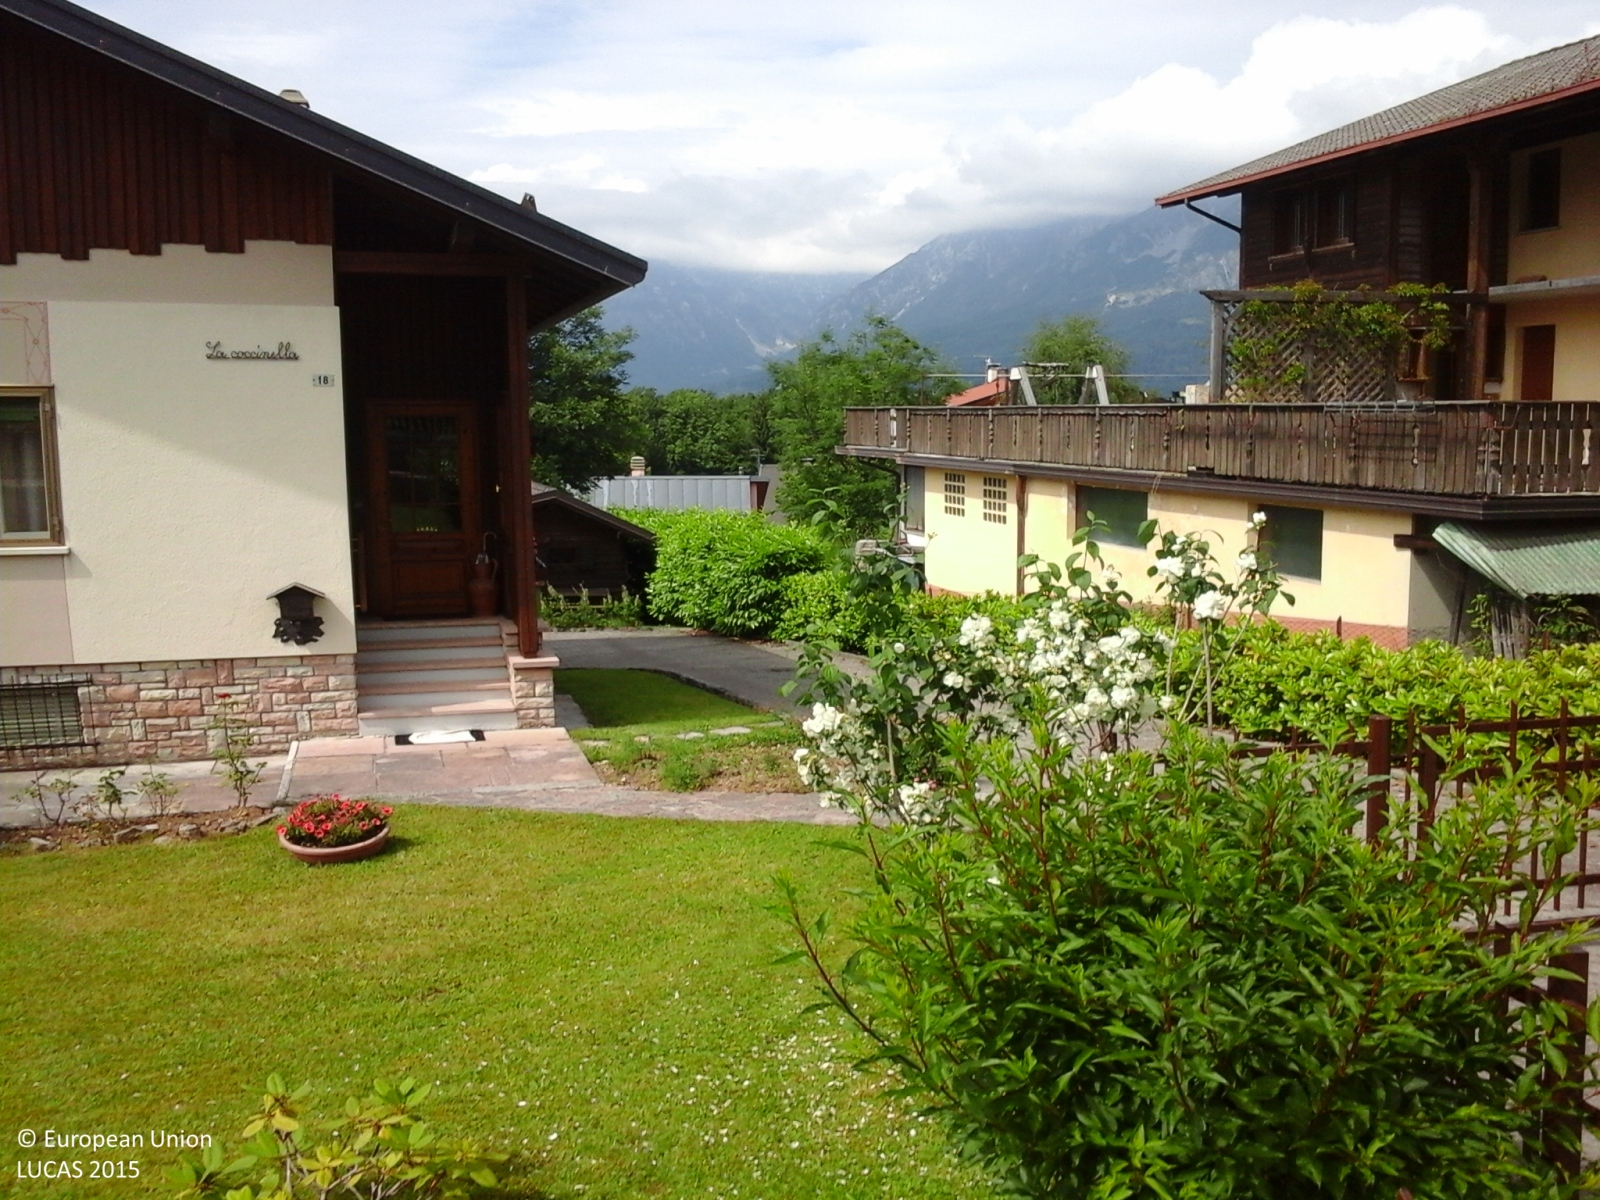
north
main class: Grassland
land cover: Grassland with sparse tree/shrub cover
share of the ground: > 75 %
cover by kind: herbaceous plants 95 %, broadleaved forest trees 5 %
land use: Residential
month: June
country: IT
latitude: 46.1257
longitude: 12.4171
